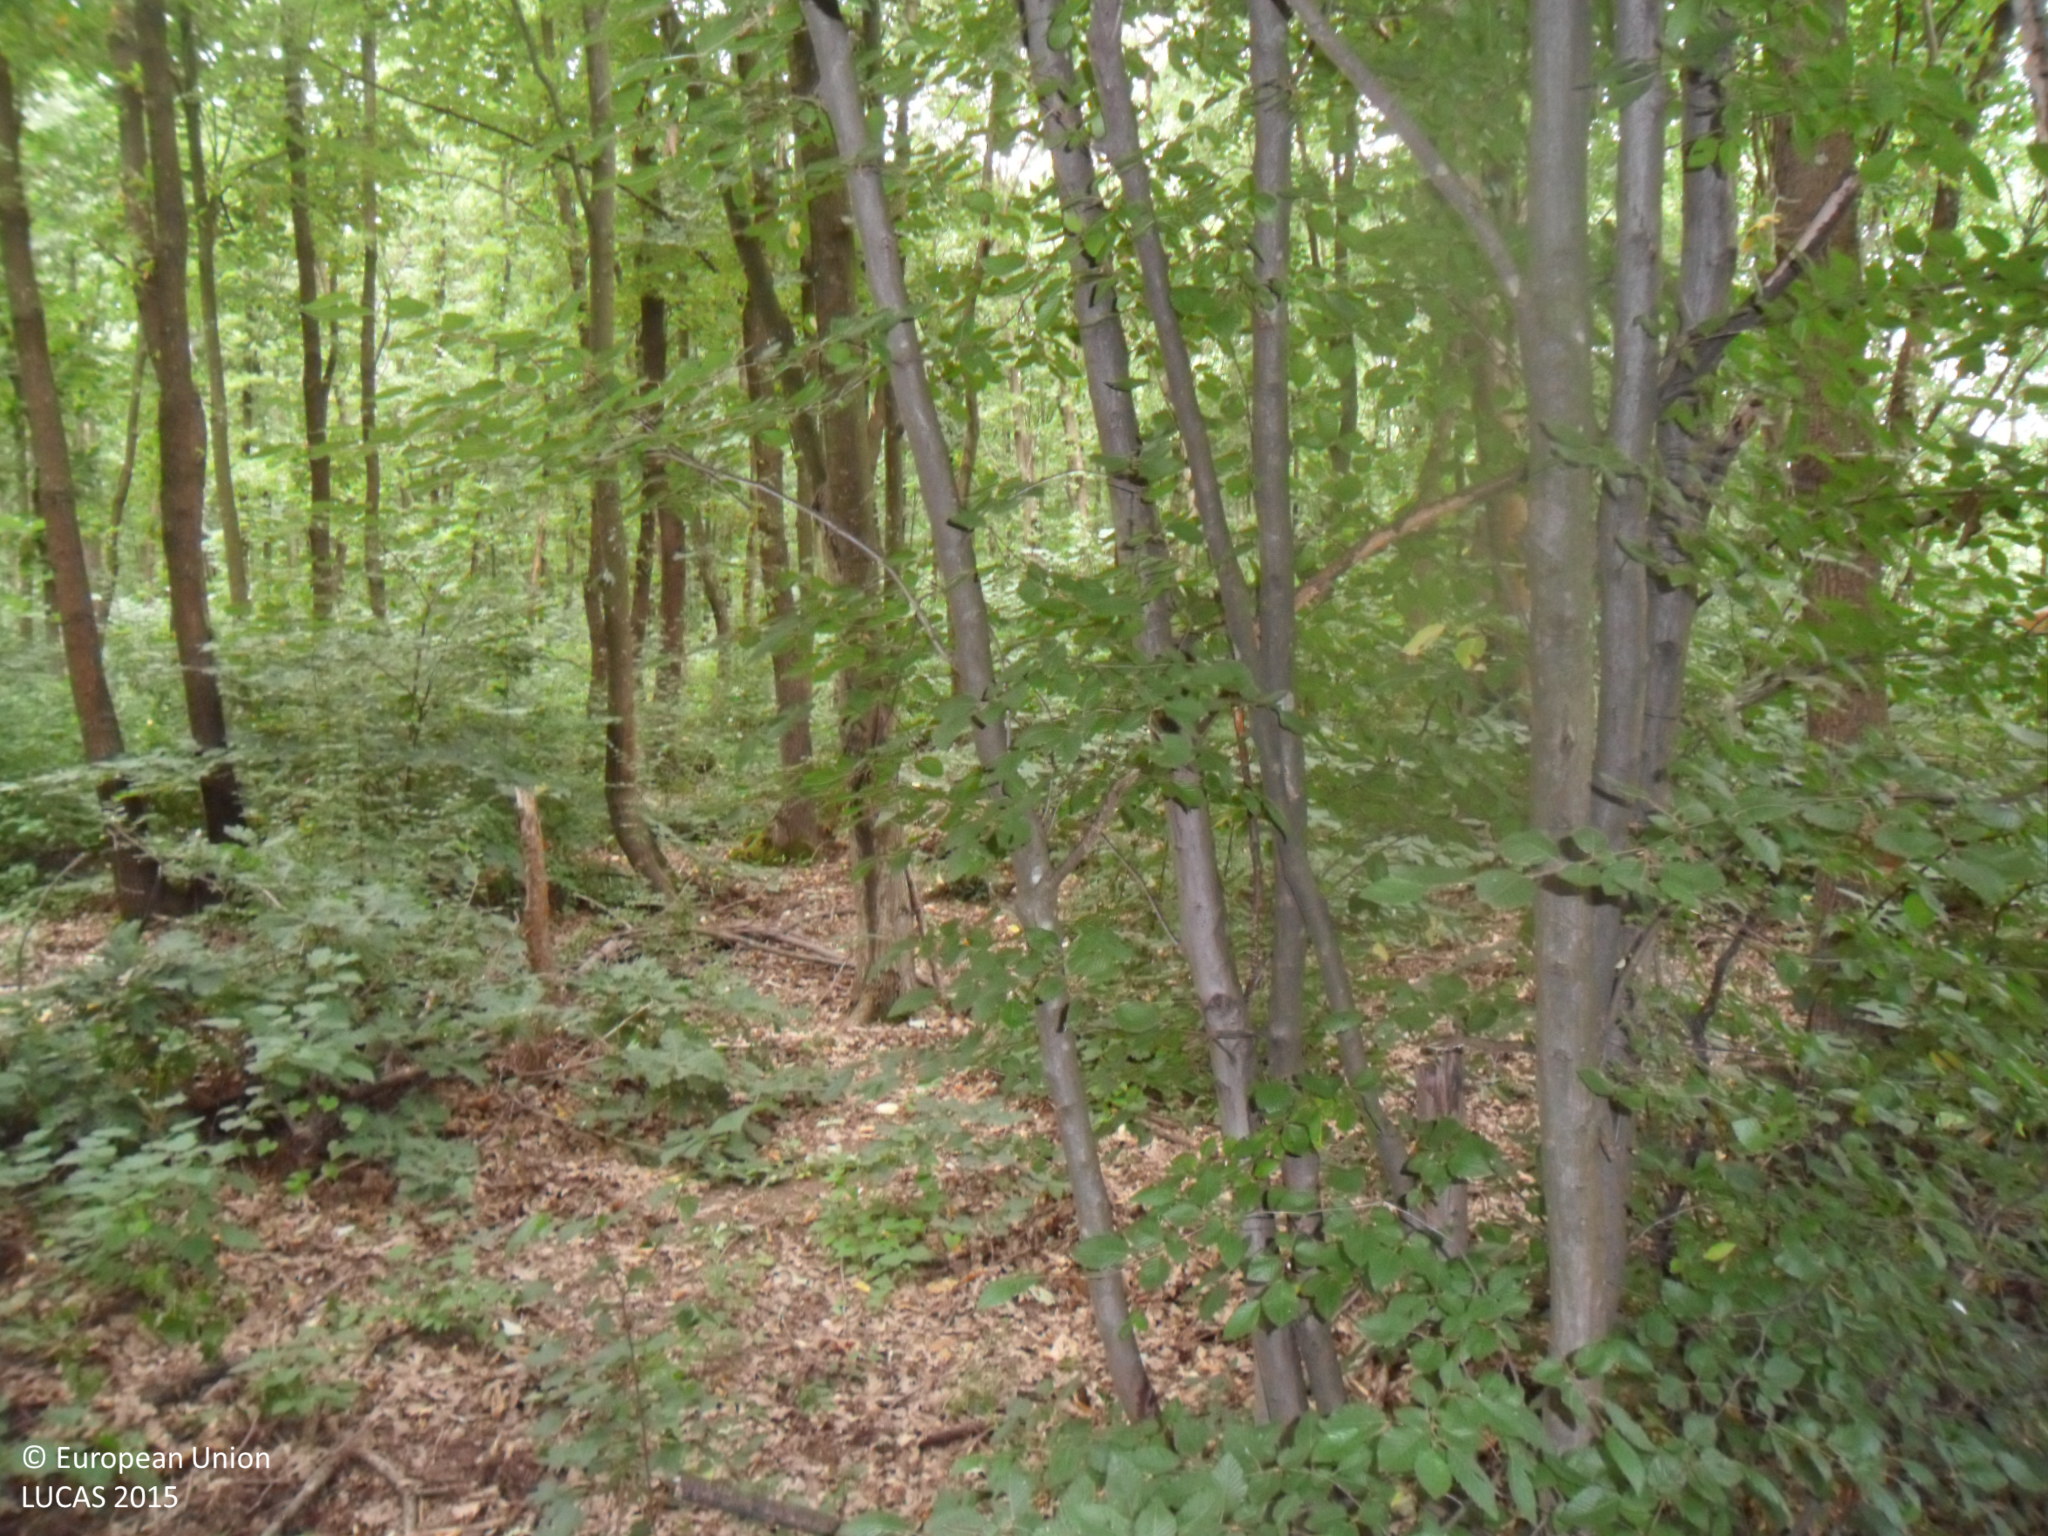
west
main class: Woodland
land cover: Broadleaved woodland
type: mesophytic deciduous forest
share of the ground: > 75 %
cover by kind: broadleaved forest trees 100 %
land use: Forestry
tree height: > 5 m
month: June
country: BG
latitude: 43.1335
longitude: 26.9157
